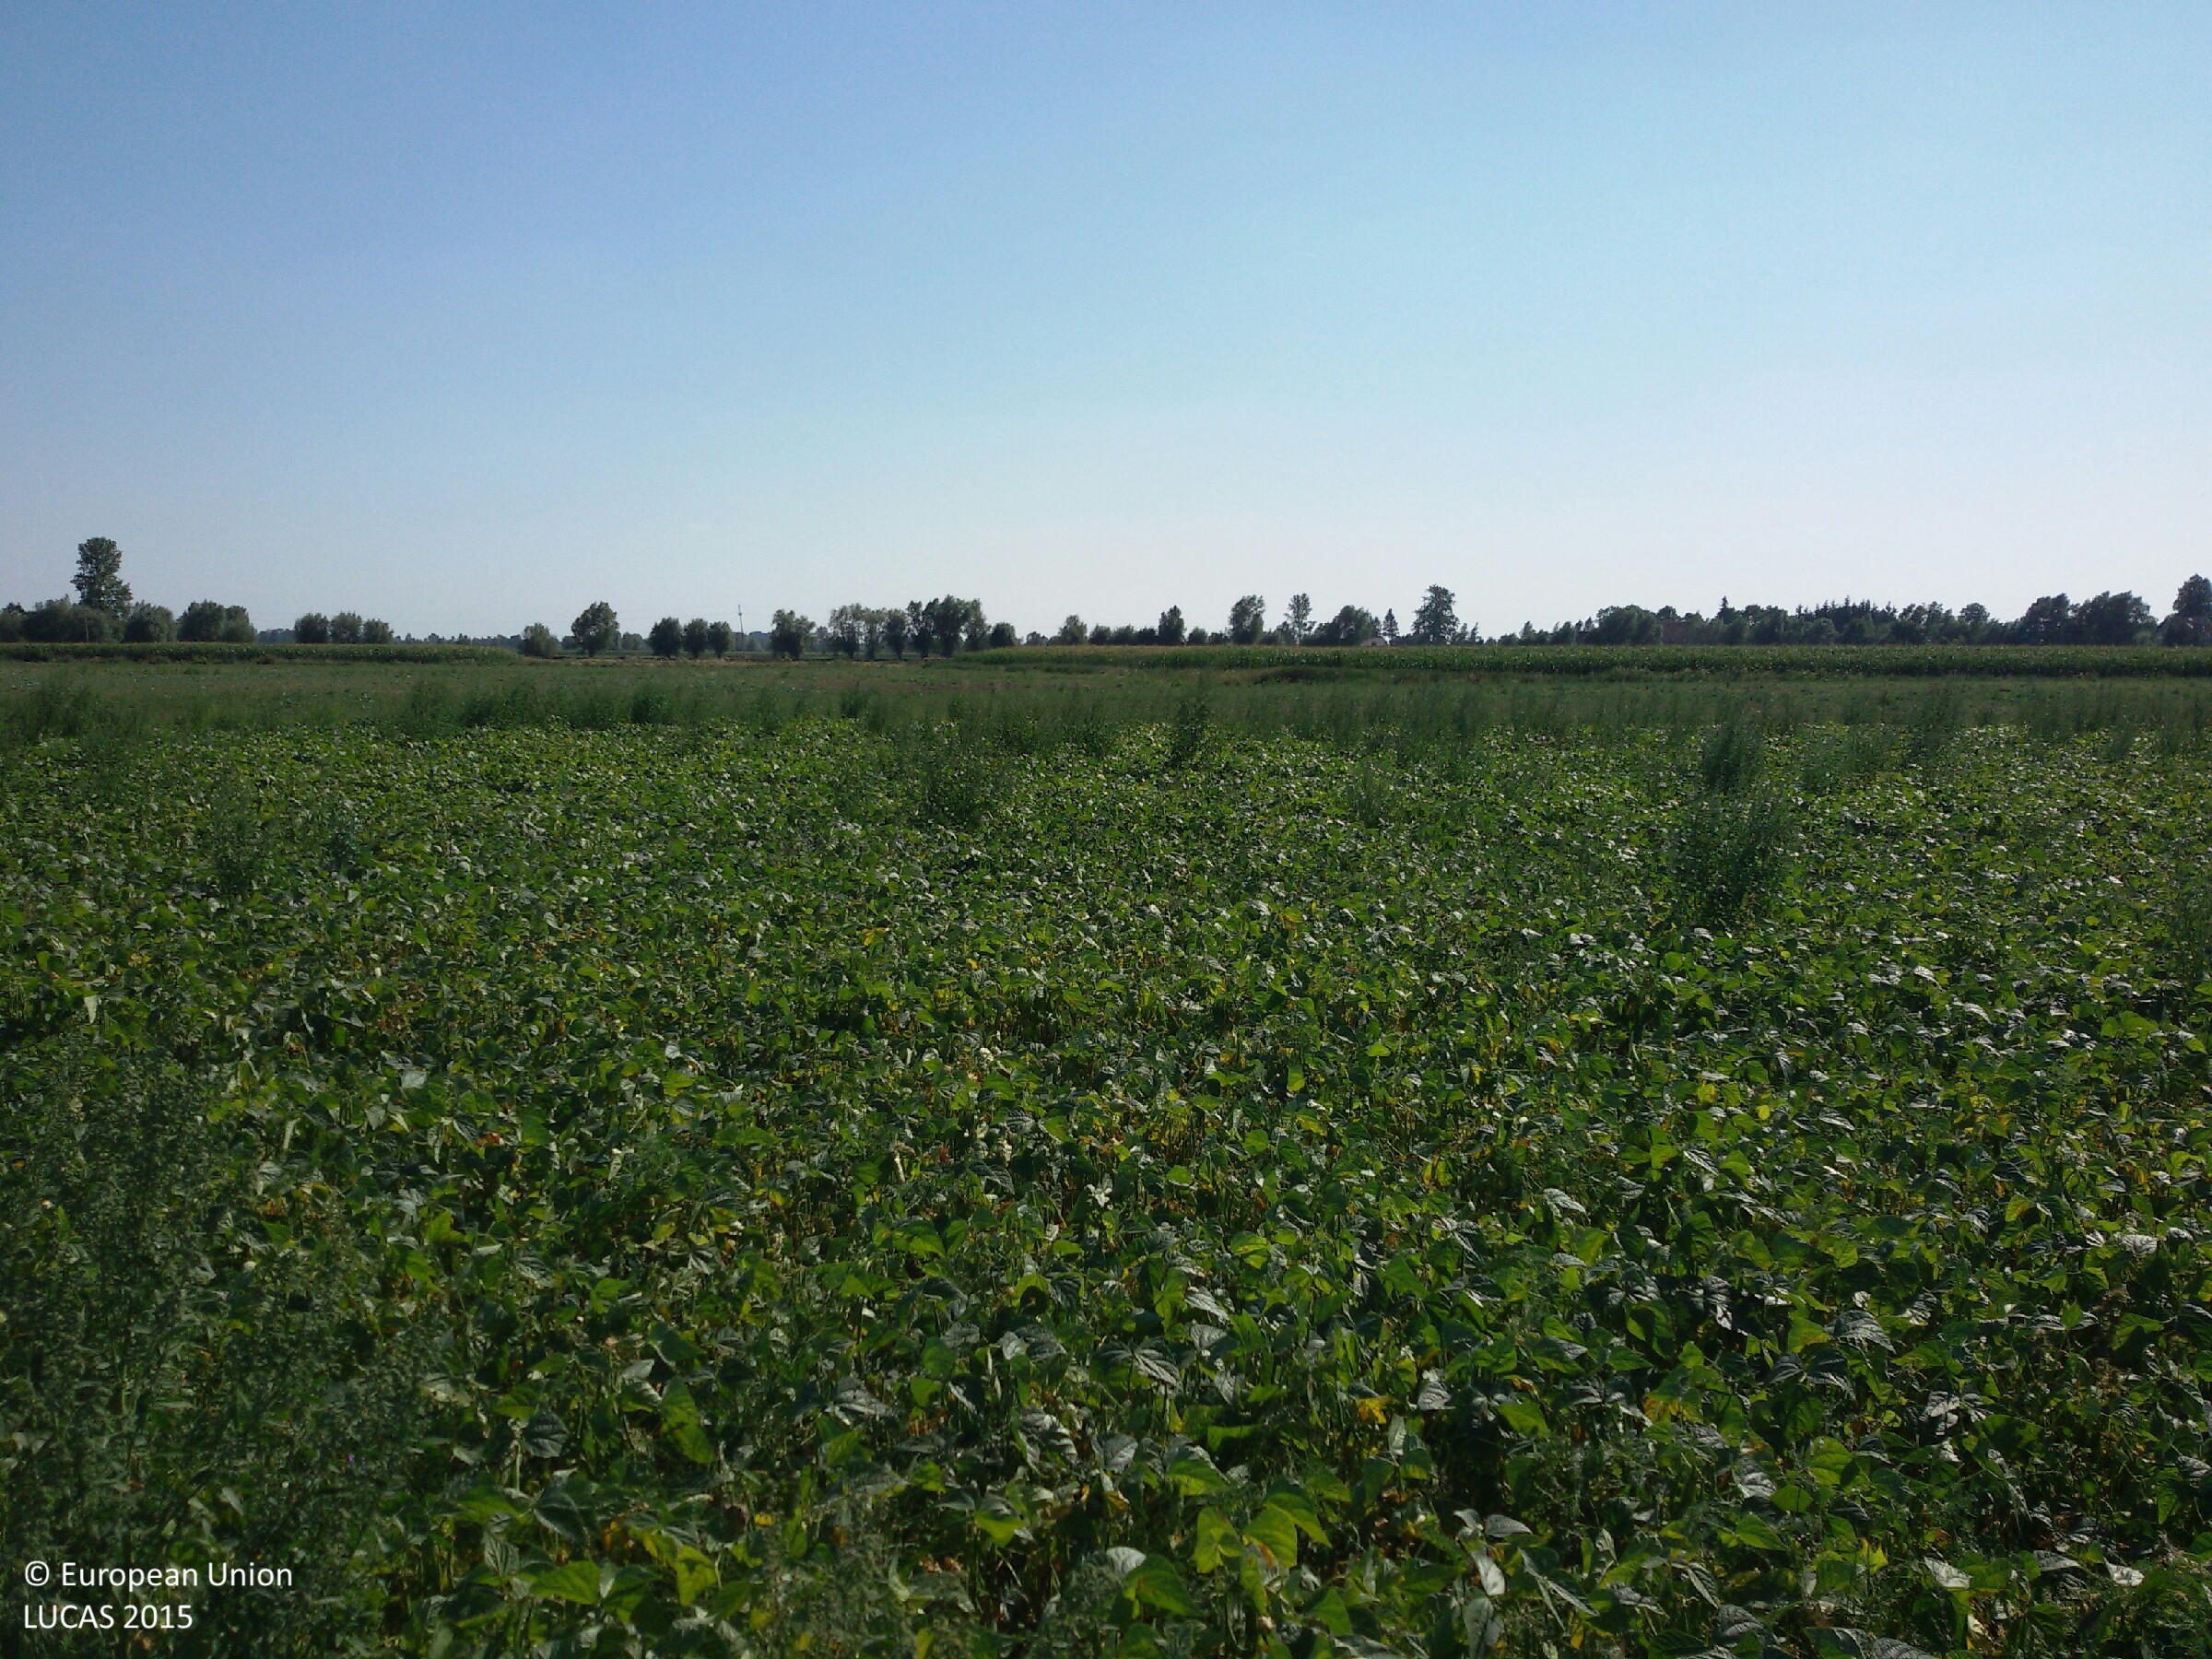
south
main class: Cropland
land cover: Dry pulses
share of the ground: > 75 %
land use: Agriculture (excluding fallow land and kitchen gardens)
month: August
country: PL
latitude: 54.1061
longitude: 19.3697
